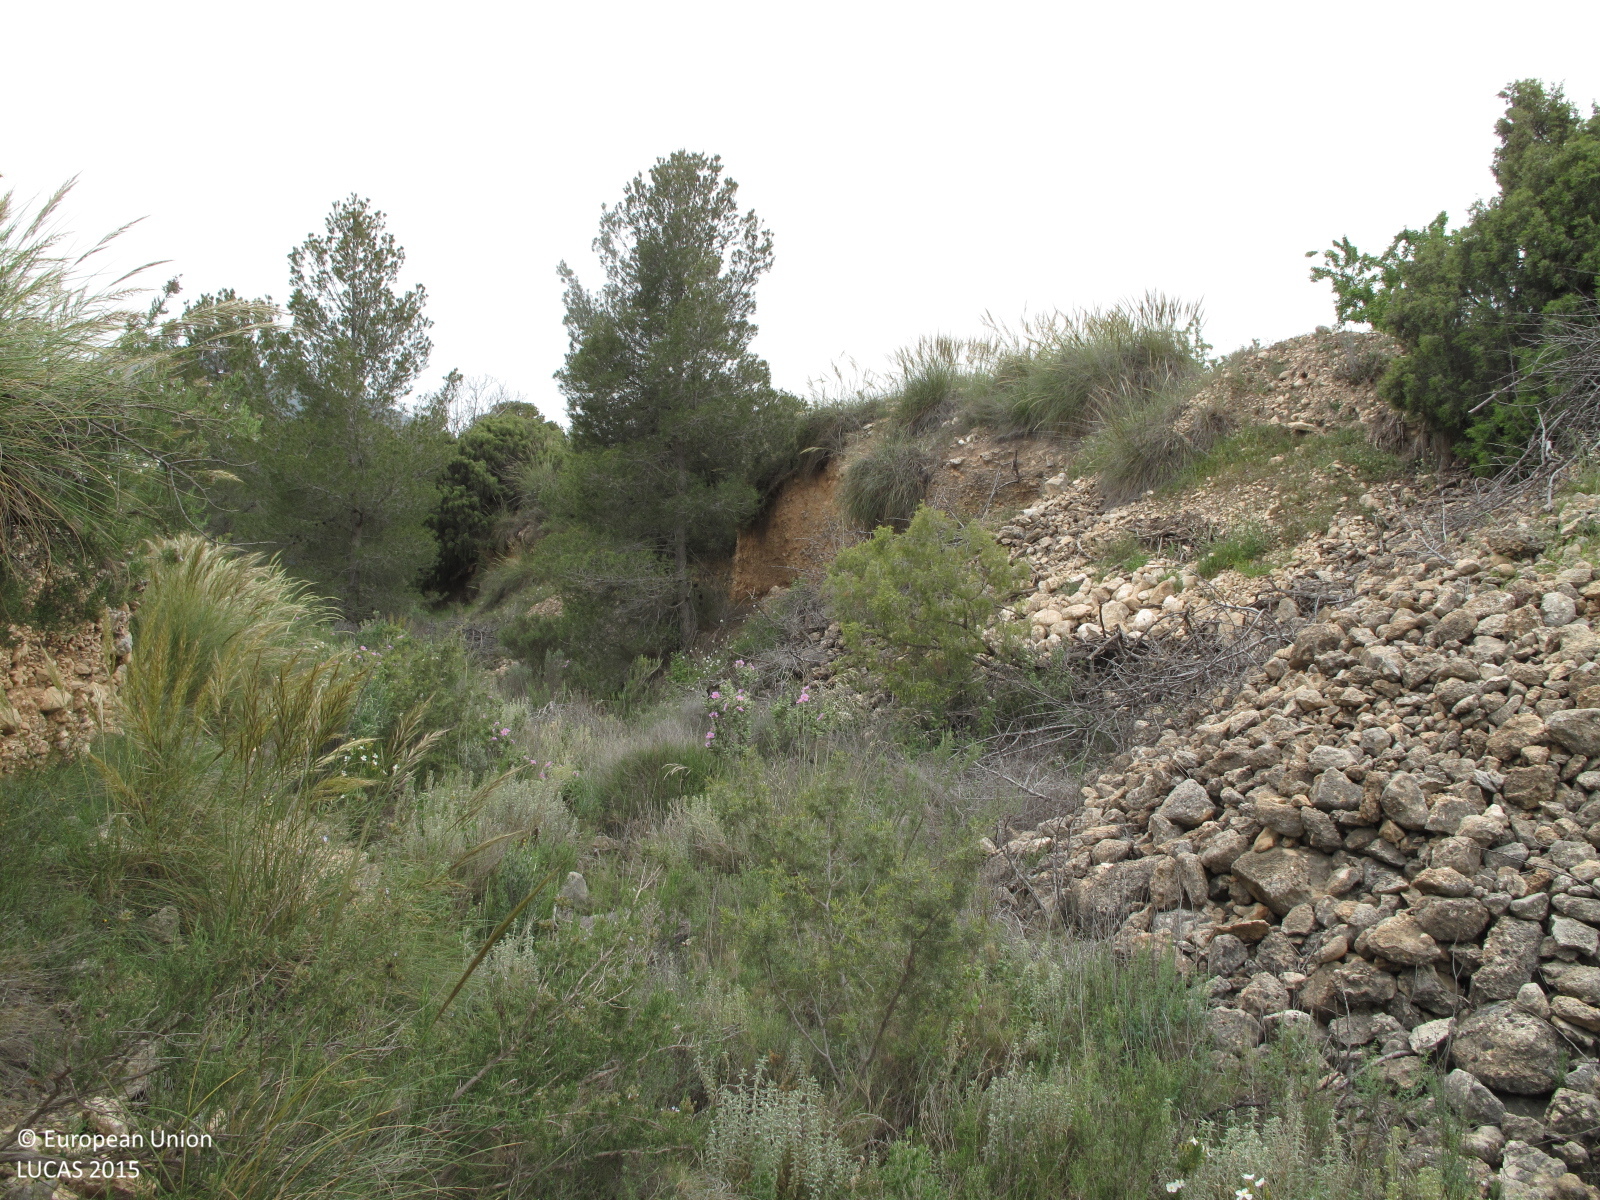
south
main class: Woodland
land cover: Other coniferous woodland
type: coniferous forest of the mediterranean region
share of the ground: 25 - 50 %
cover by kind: coniferous forest trees 45 %, shrubs 20 %, consolidated bare surface 20 %, herbaceous plants 15 %
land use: Semi-natural and natural areas not in use
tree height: > 5 m
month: April
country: ES
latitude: 38.5035
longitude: -0.9400
